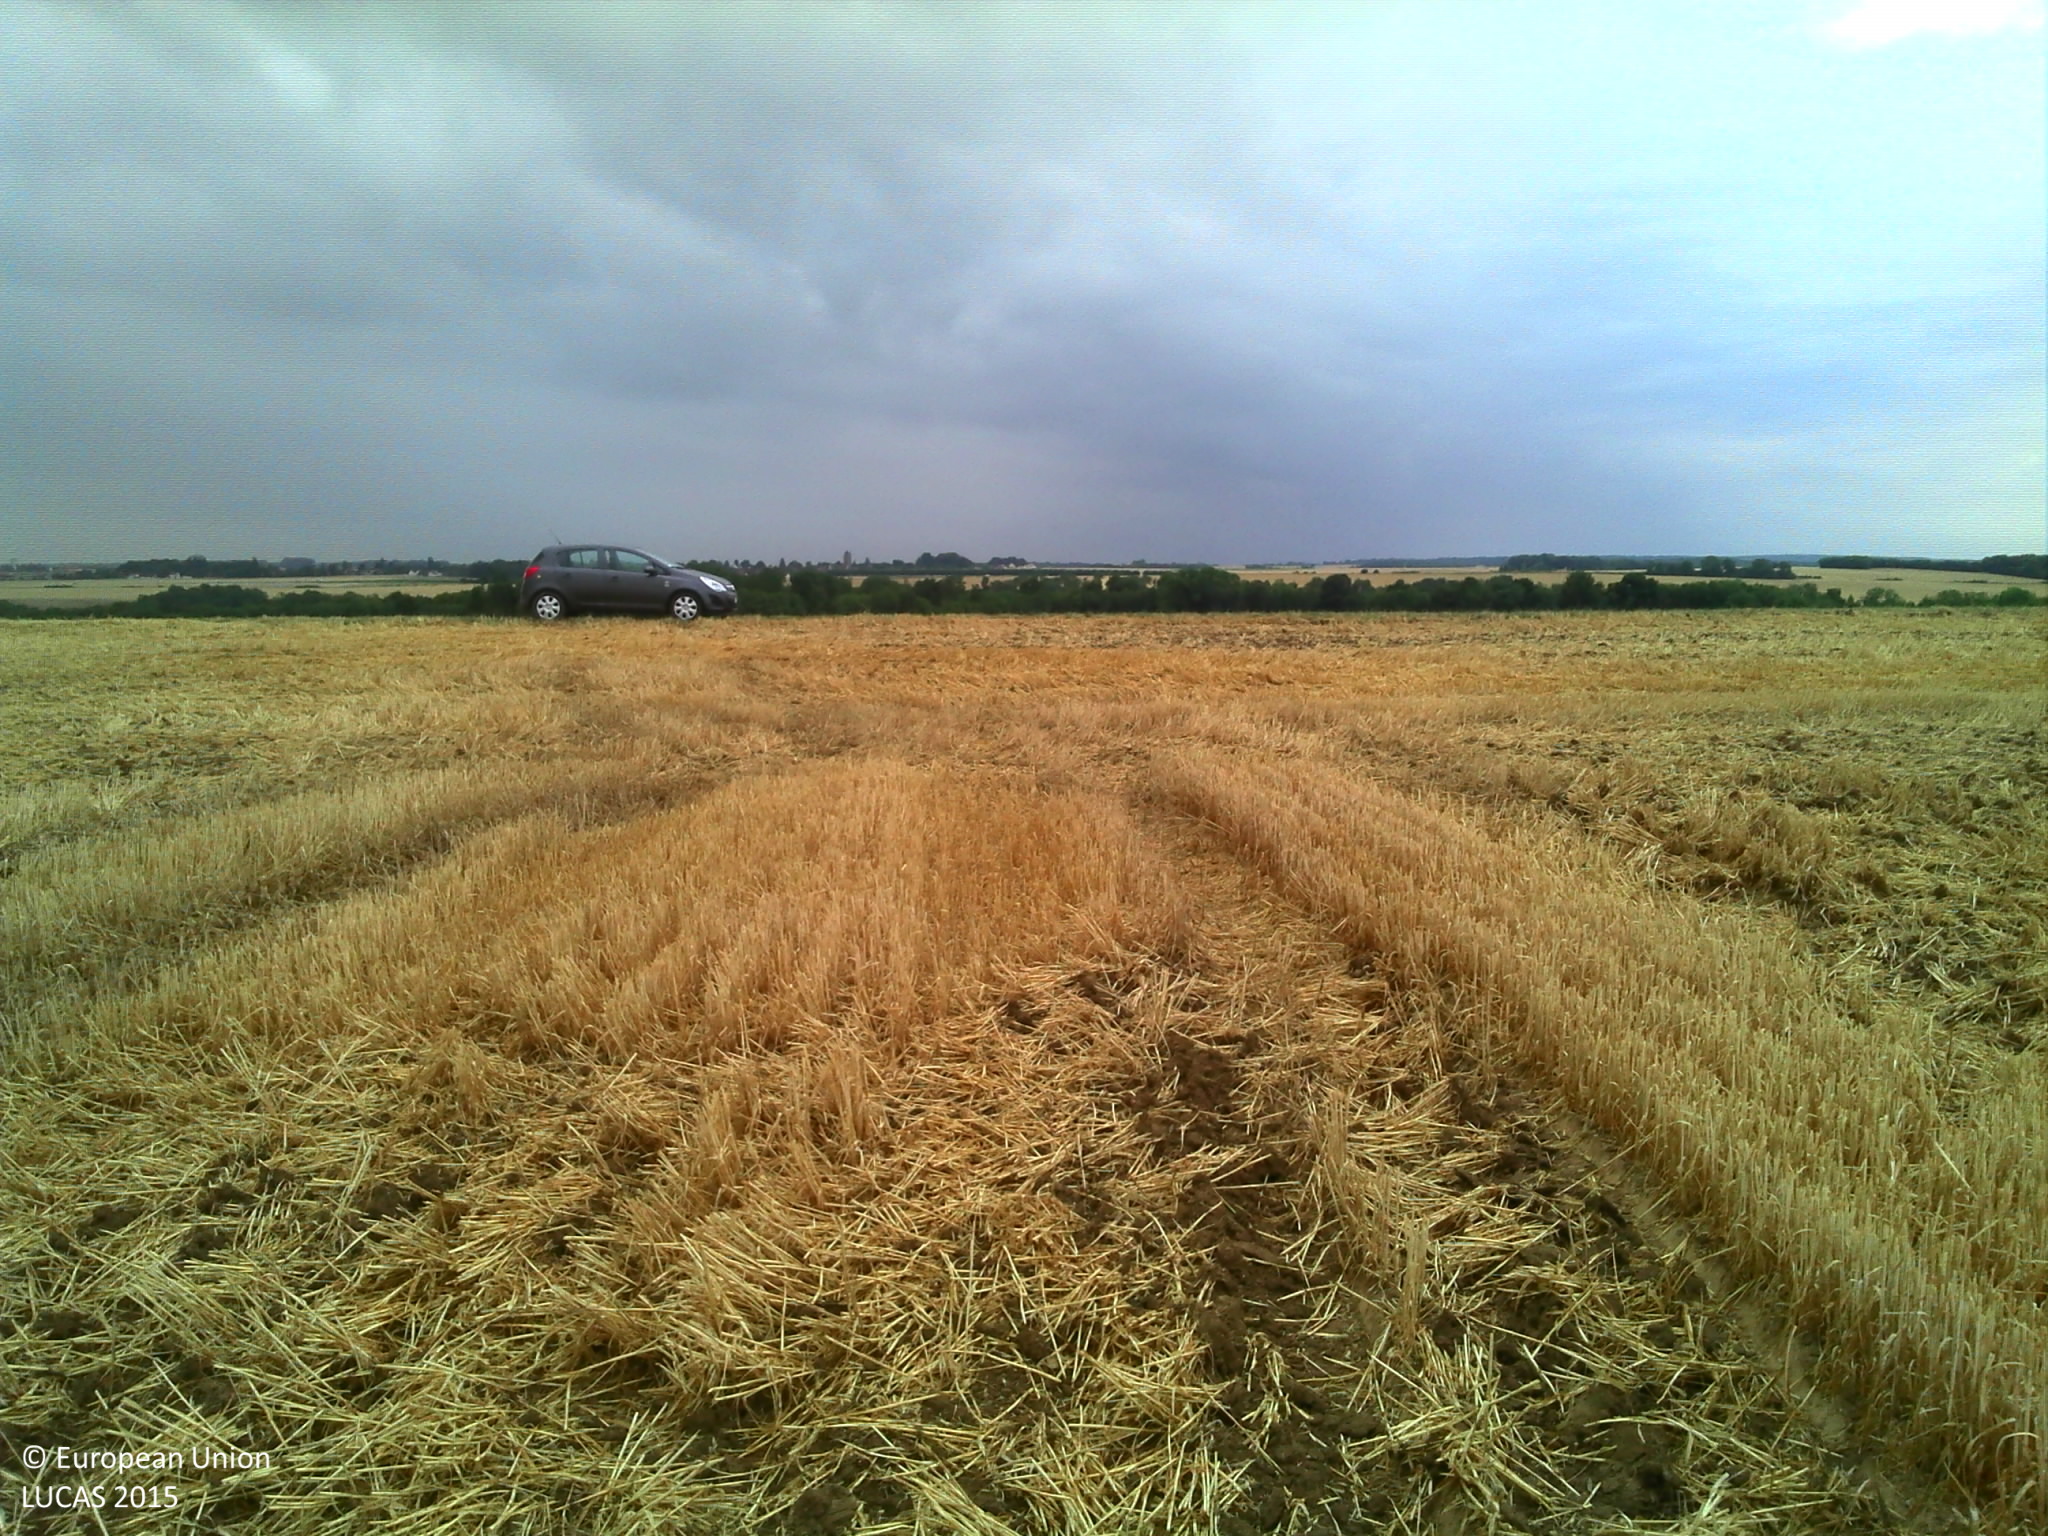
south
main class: Cropland
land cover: Common wheat
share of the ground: > 75 %
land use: Agriculture (excluding fallow land and kitchen gardens)
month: August
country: FR
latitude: 48.5637
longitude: 3.3398
